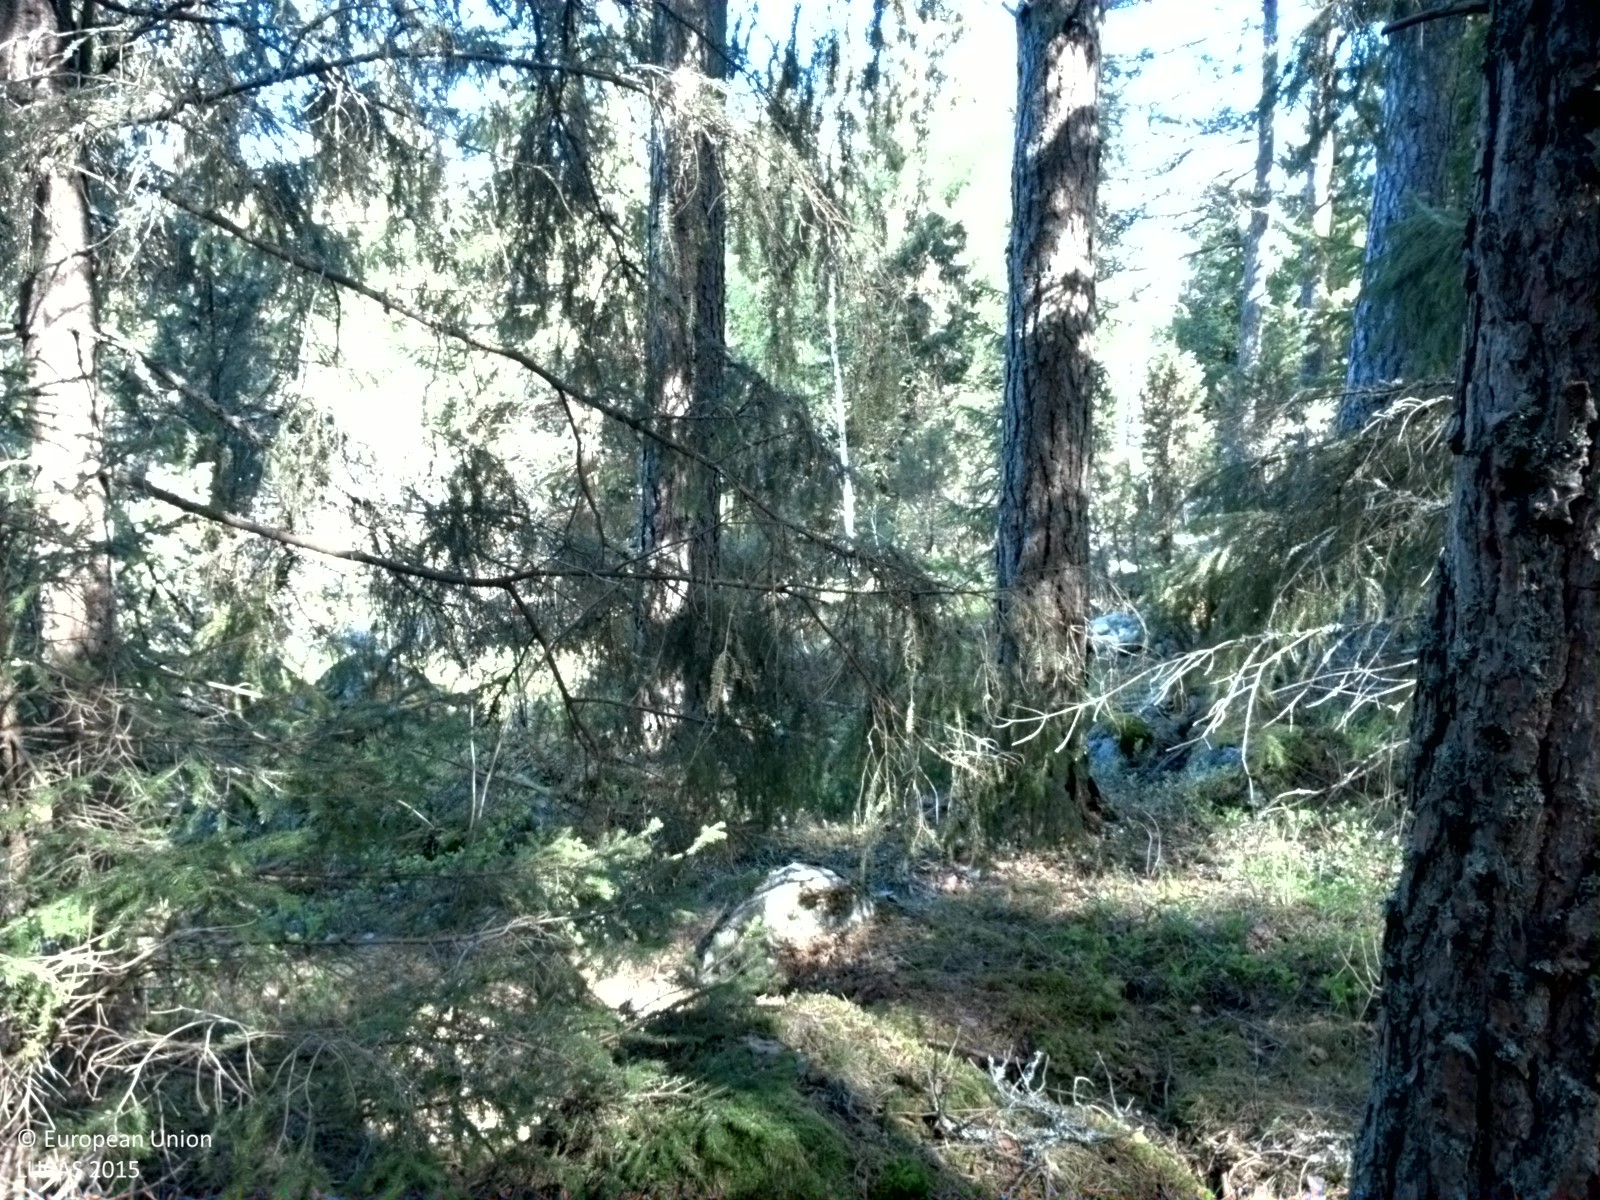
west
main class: Woodland
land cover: Spruce dominated coniferous woodland
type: boreal forest
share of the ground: > 75 %
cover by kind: coniferous forest trees 75 %, lichens and mosses 10 %, herbaceous plants 5 %, consolidated bare surface 5 %
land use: Forestry
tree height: > 5 m
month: May
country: SE
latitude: 60.1361
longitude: 17.9702
